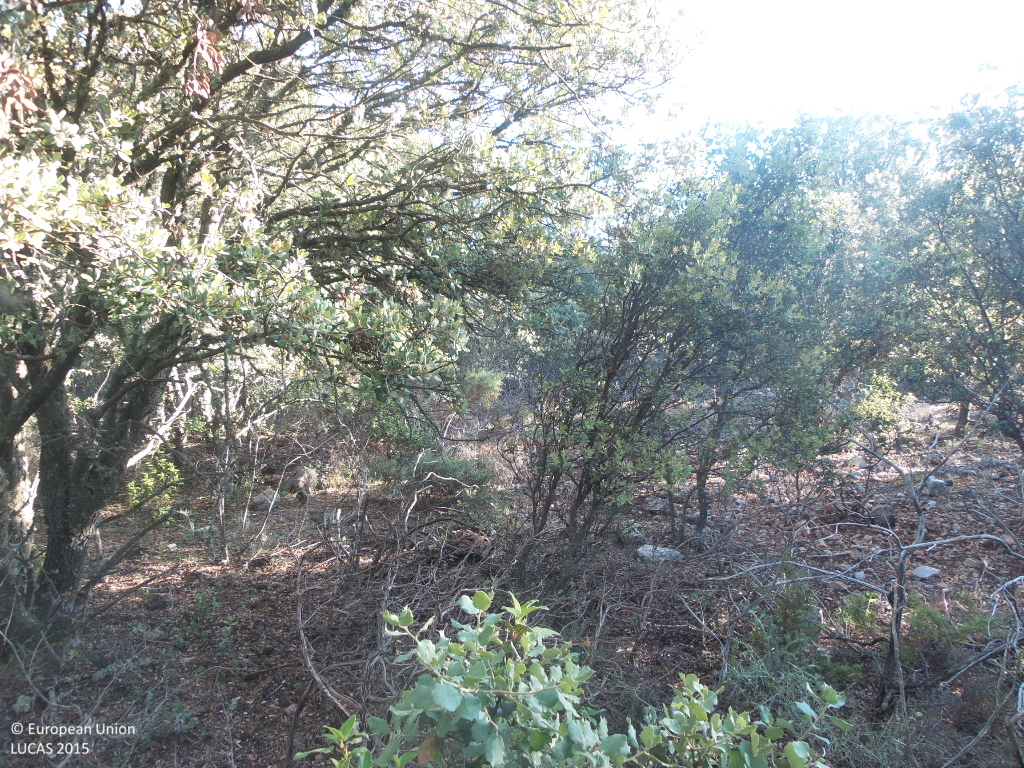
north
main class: Woodland
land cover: Broadleaved woodland
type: broadleaved evergreen forest
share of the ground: > 75 %
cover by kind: broadleaved forest trees 80 %, shrubs 10 %, herbaceous plants 5 %, unconsolidated bare surface 5 %
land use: Semi-natural and natural areas not in use
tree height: > 5 m
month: June
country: ES
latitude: 41.0373
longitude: -2.9177
